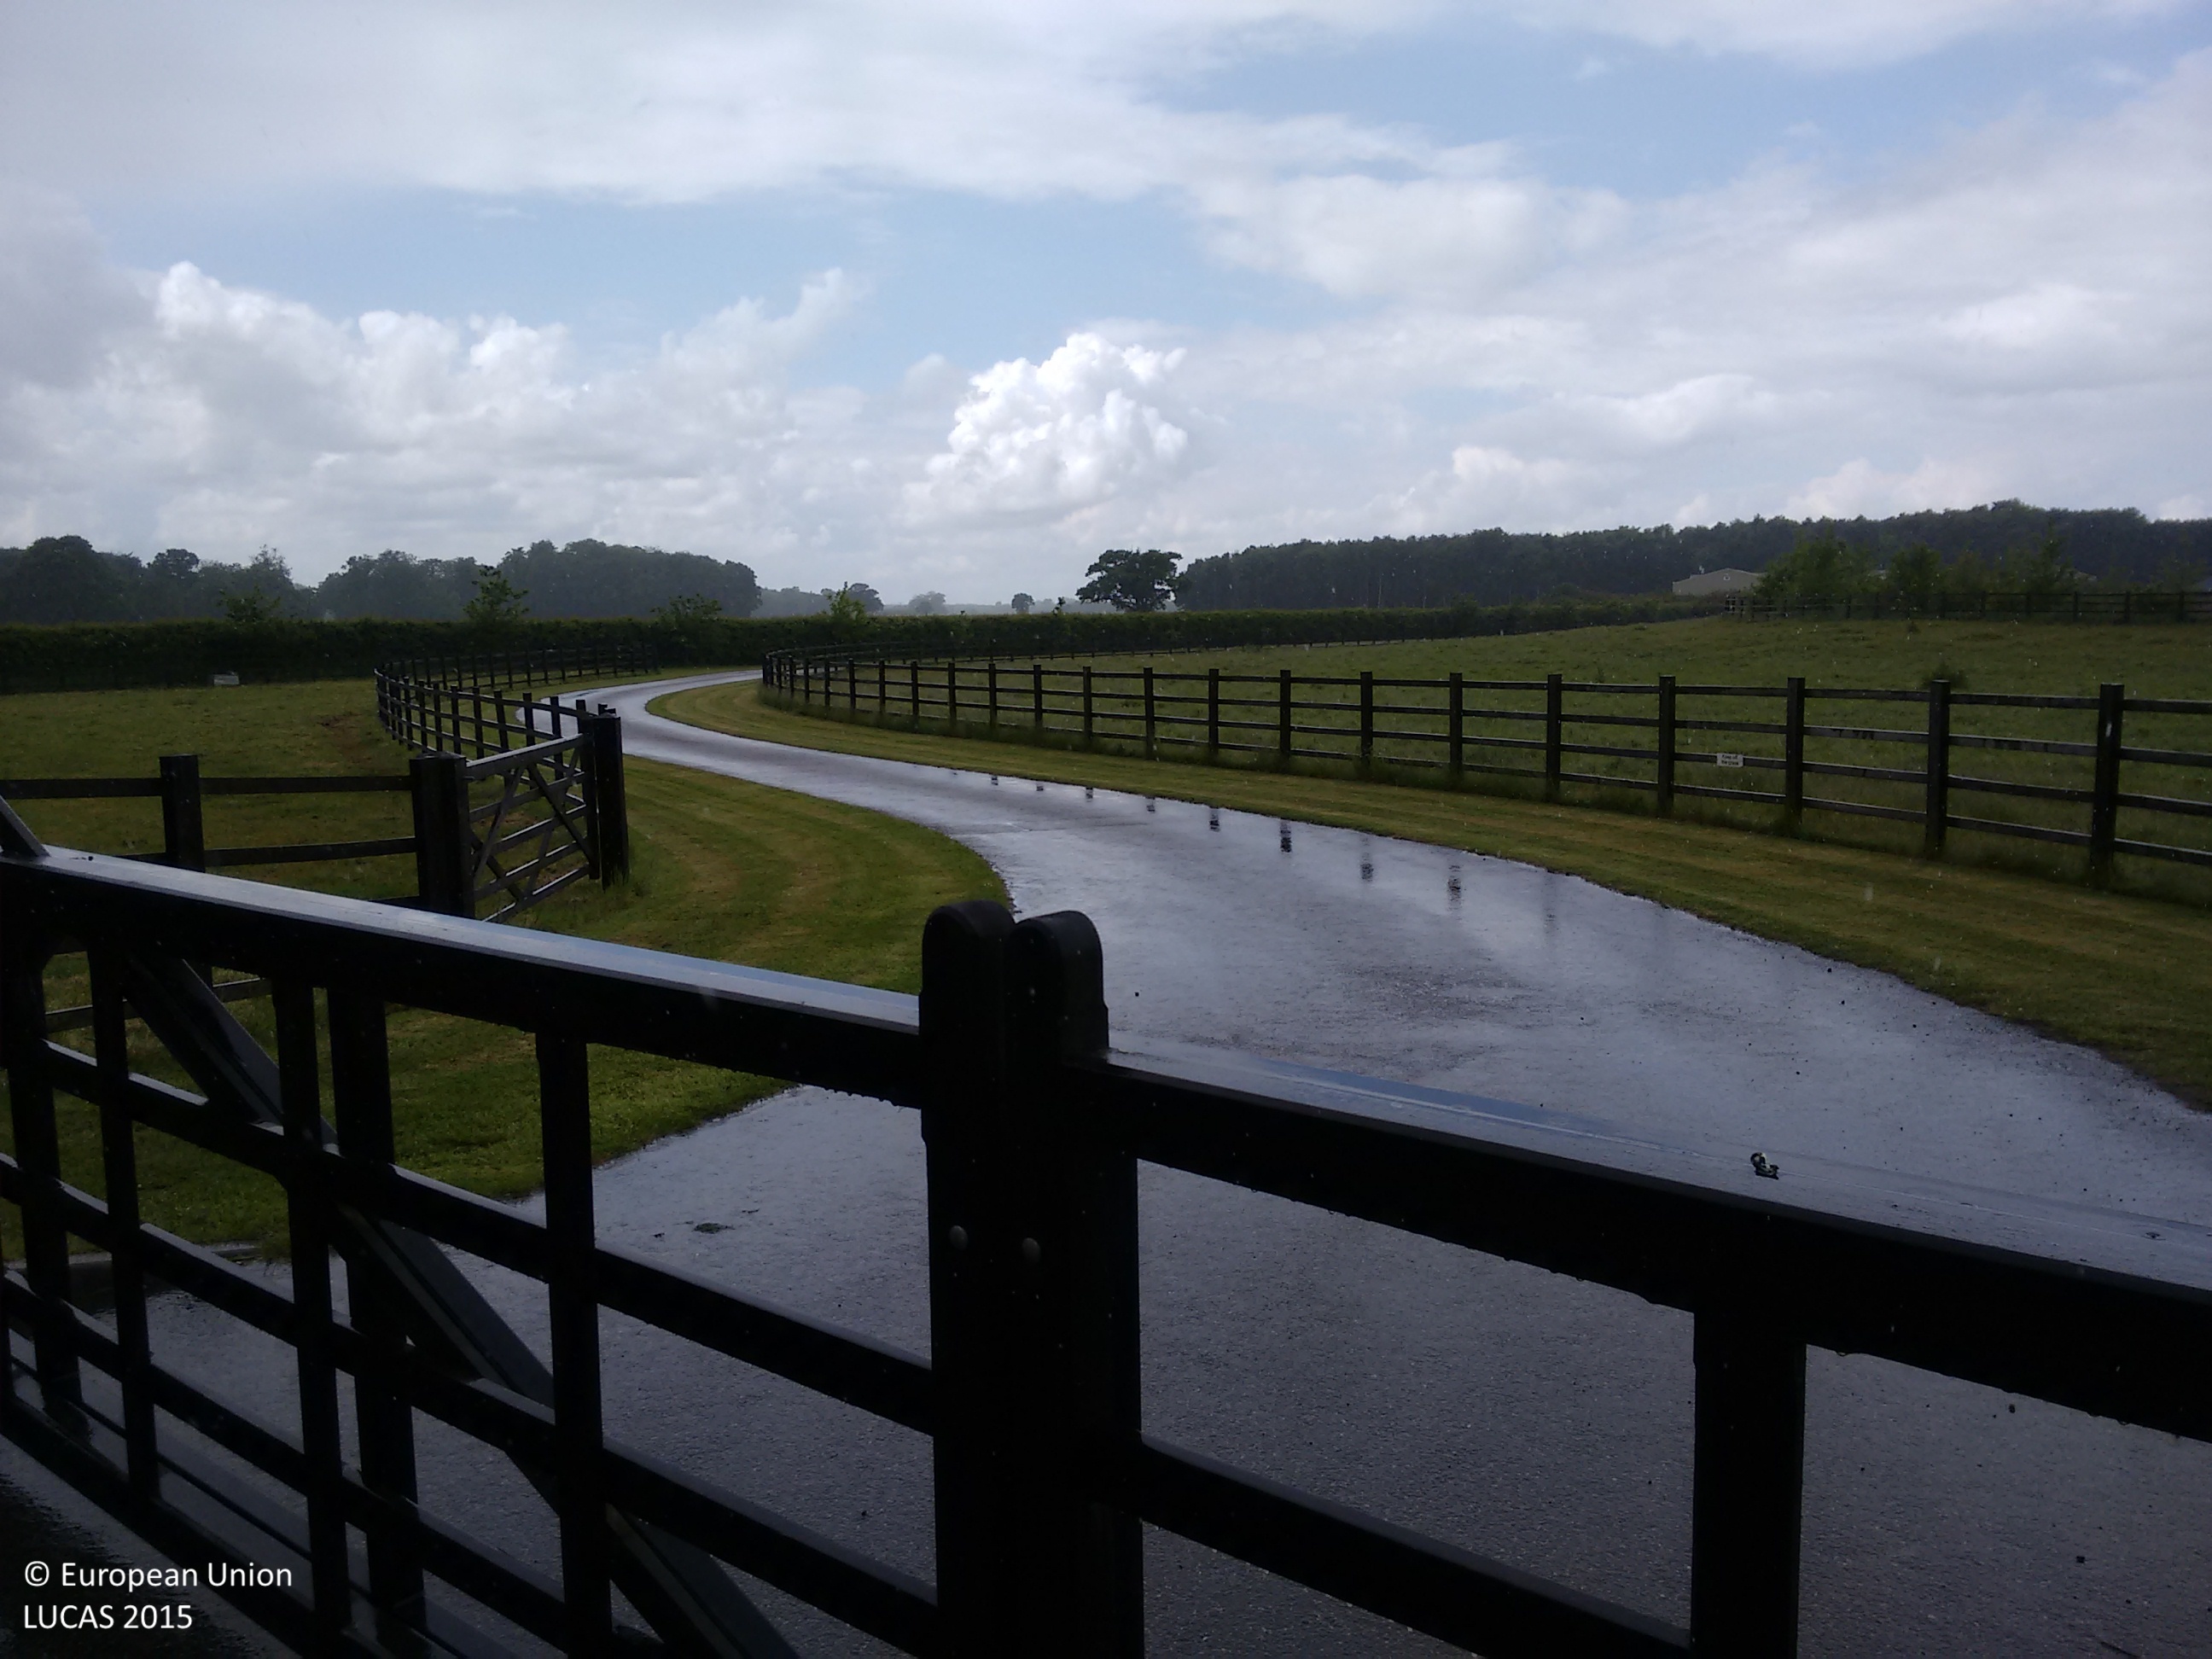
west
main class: Woodland
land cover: Broadleaved woodland
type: mesophytic deciduous forest
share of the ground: > 75 %
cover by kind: broadleaved forest trees 80 %, coniferous forest trees 20 %
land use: Semi-natural and natural areas not in use
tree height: > 5 m
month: June
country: GB
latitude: 53.8702
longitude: -1.1006
